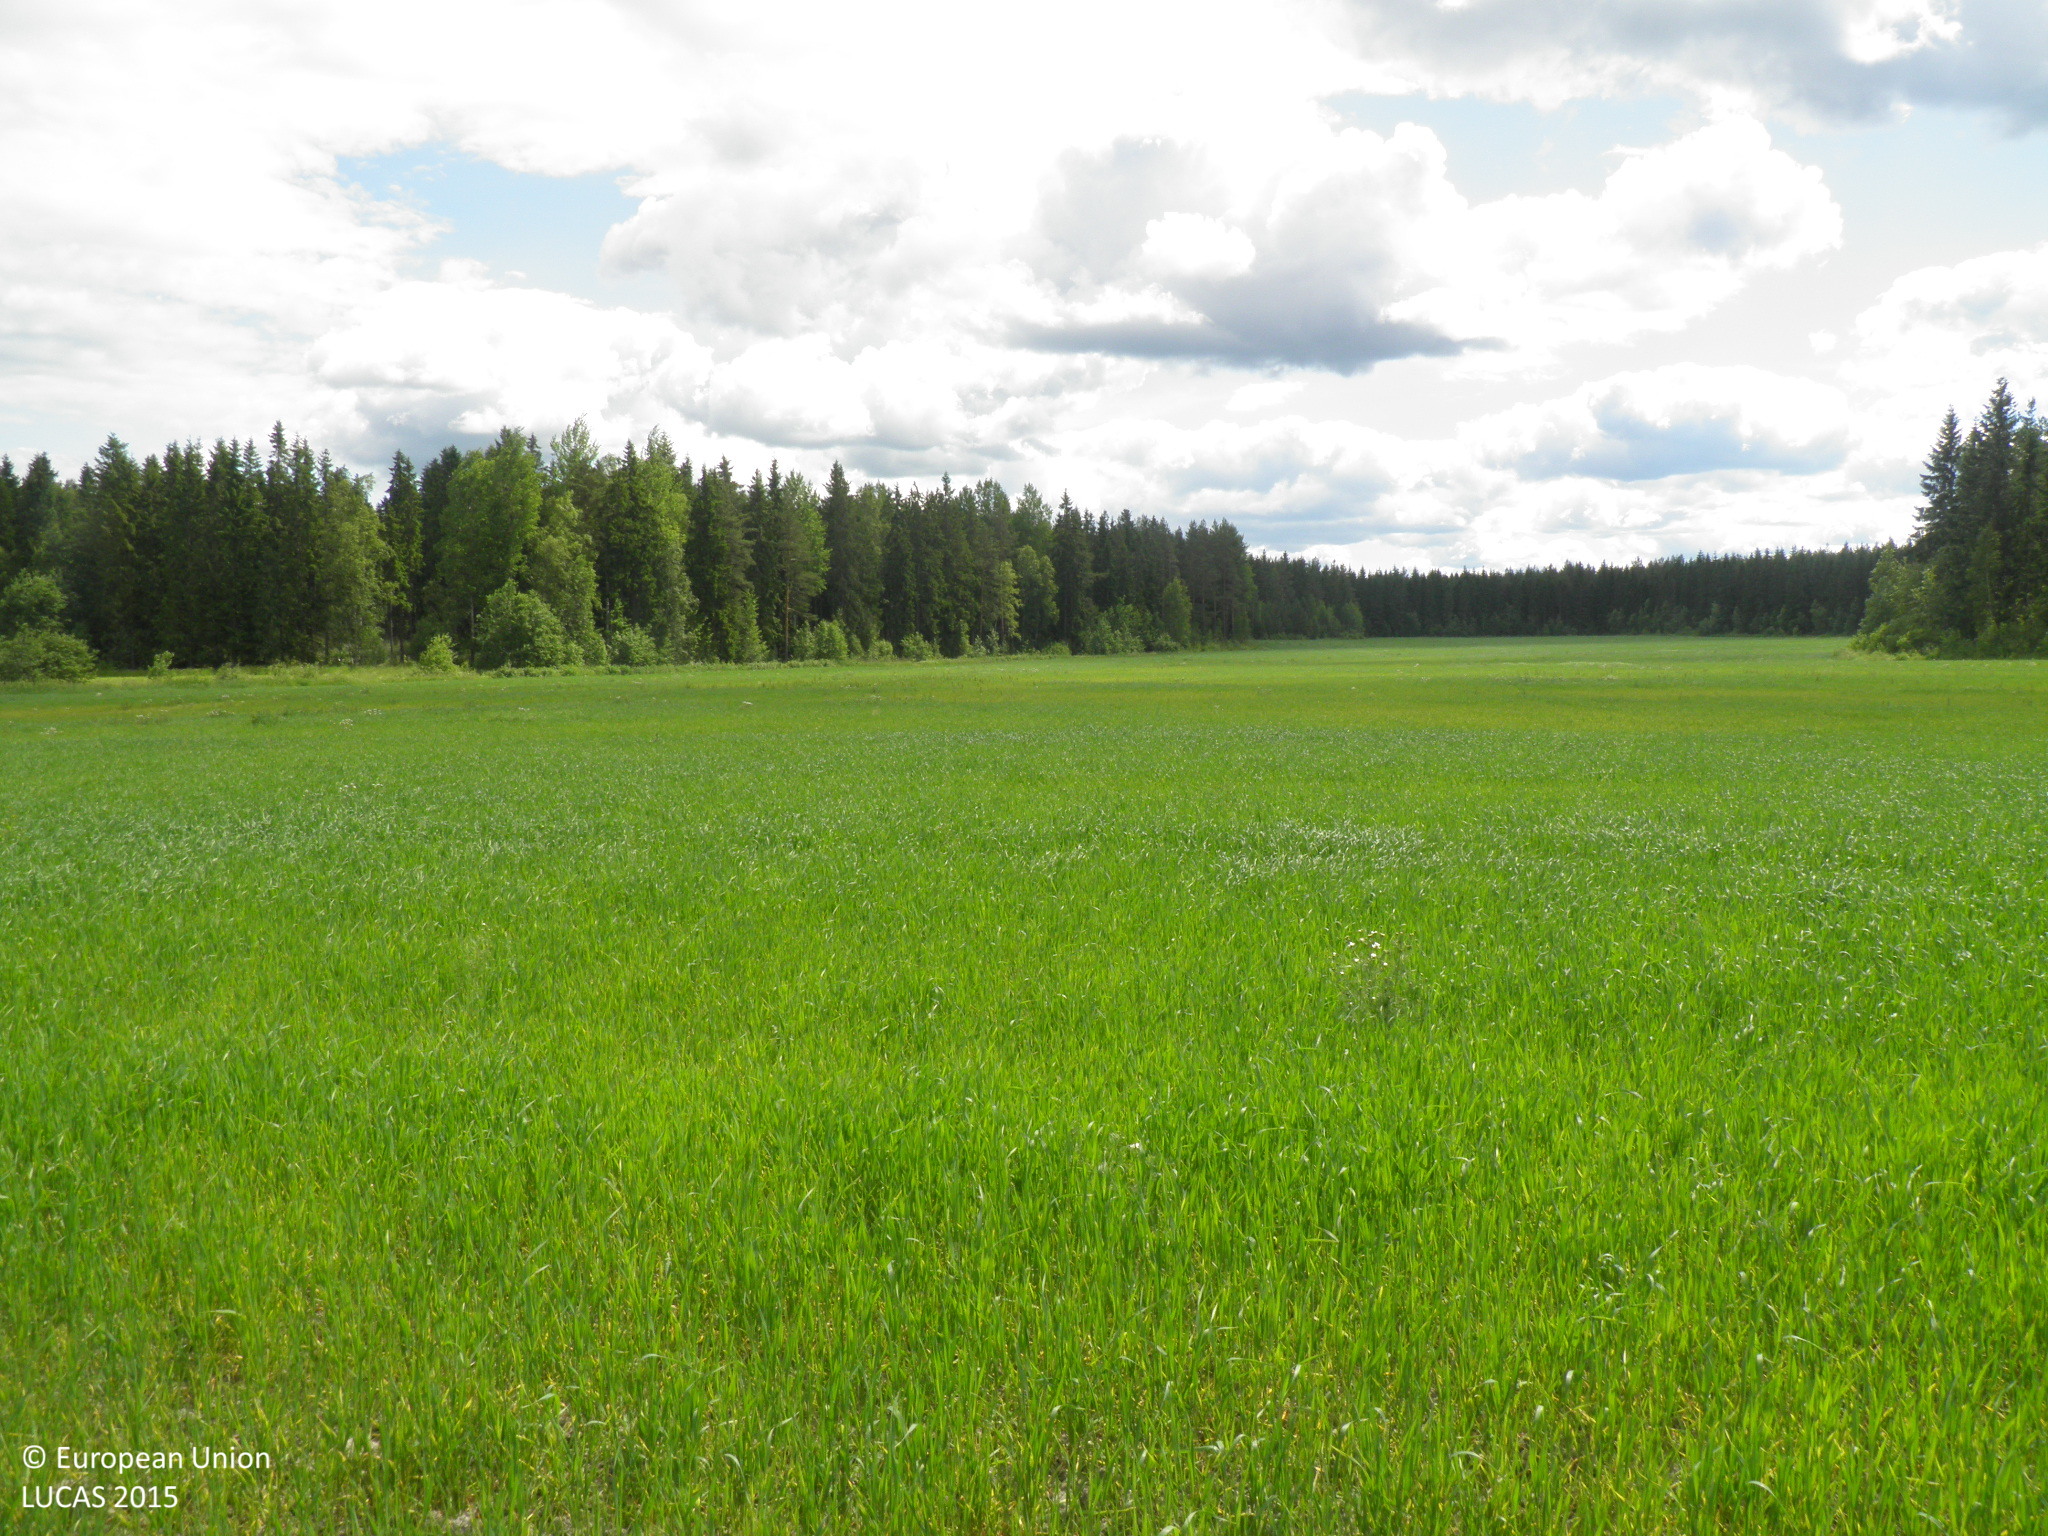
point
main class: Cropland
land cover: Common wheat
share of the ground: > 75 %
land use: Agriculture (excluding fallow land and kitchen gardens)
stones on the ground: < 10 %
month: July
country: FI
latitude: 60.6040
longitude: 22.9528
